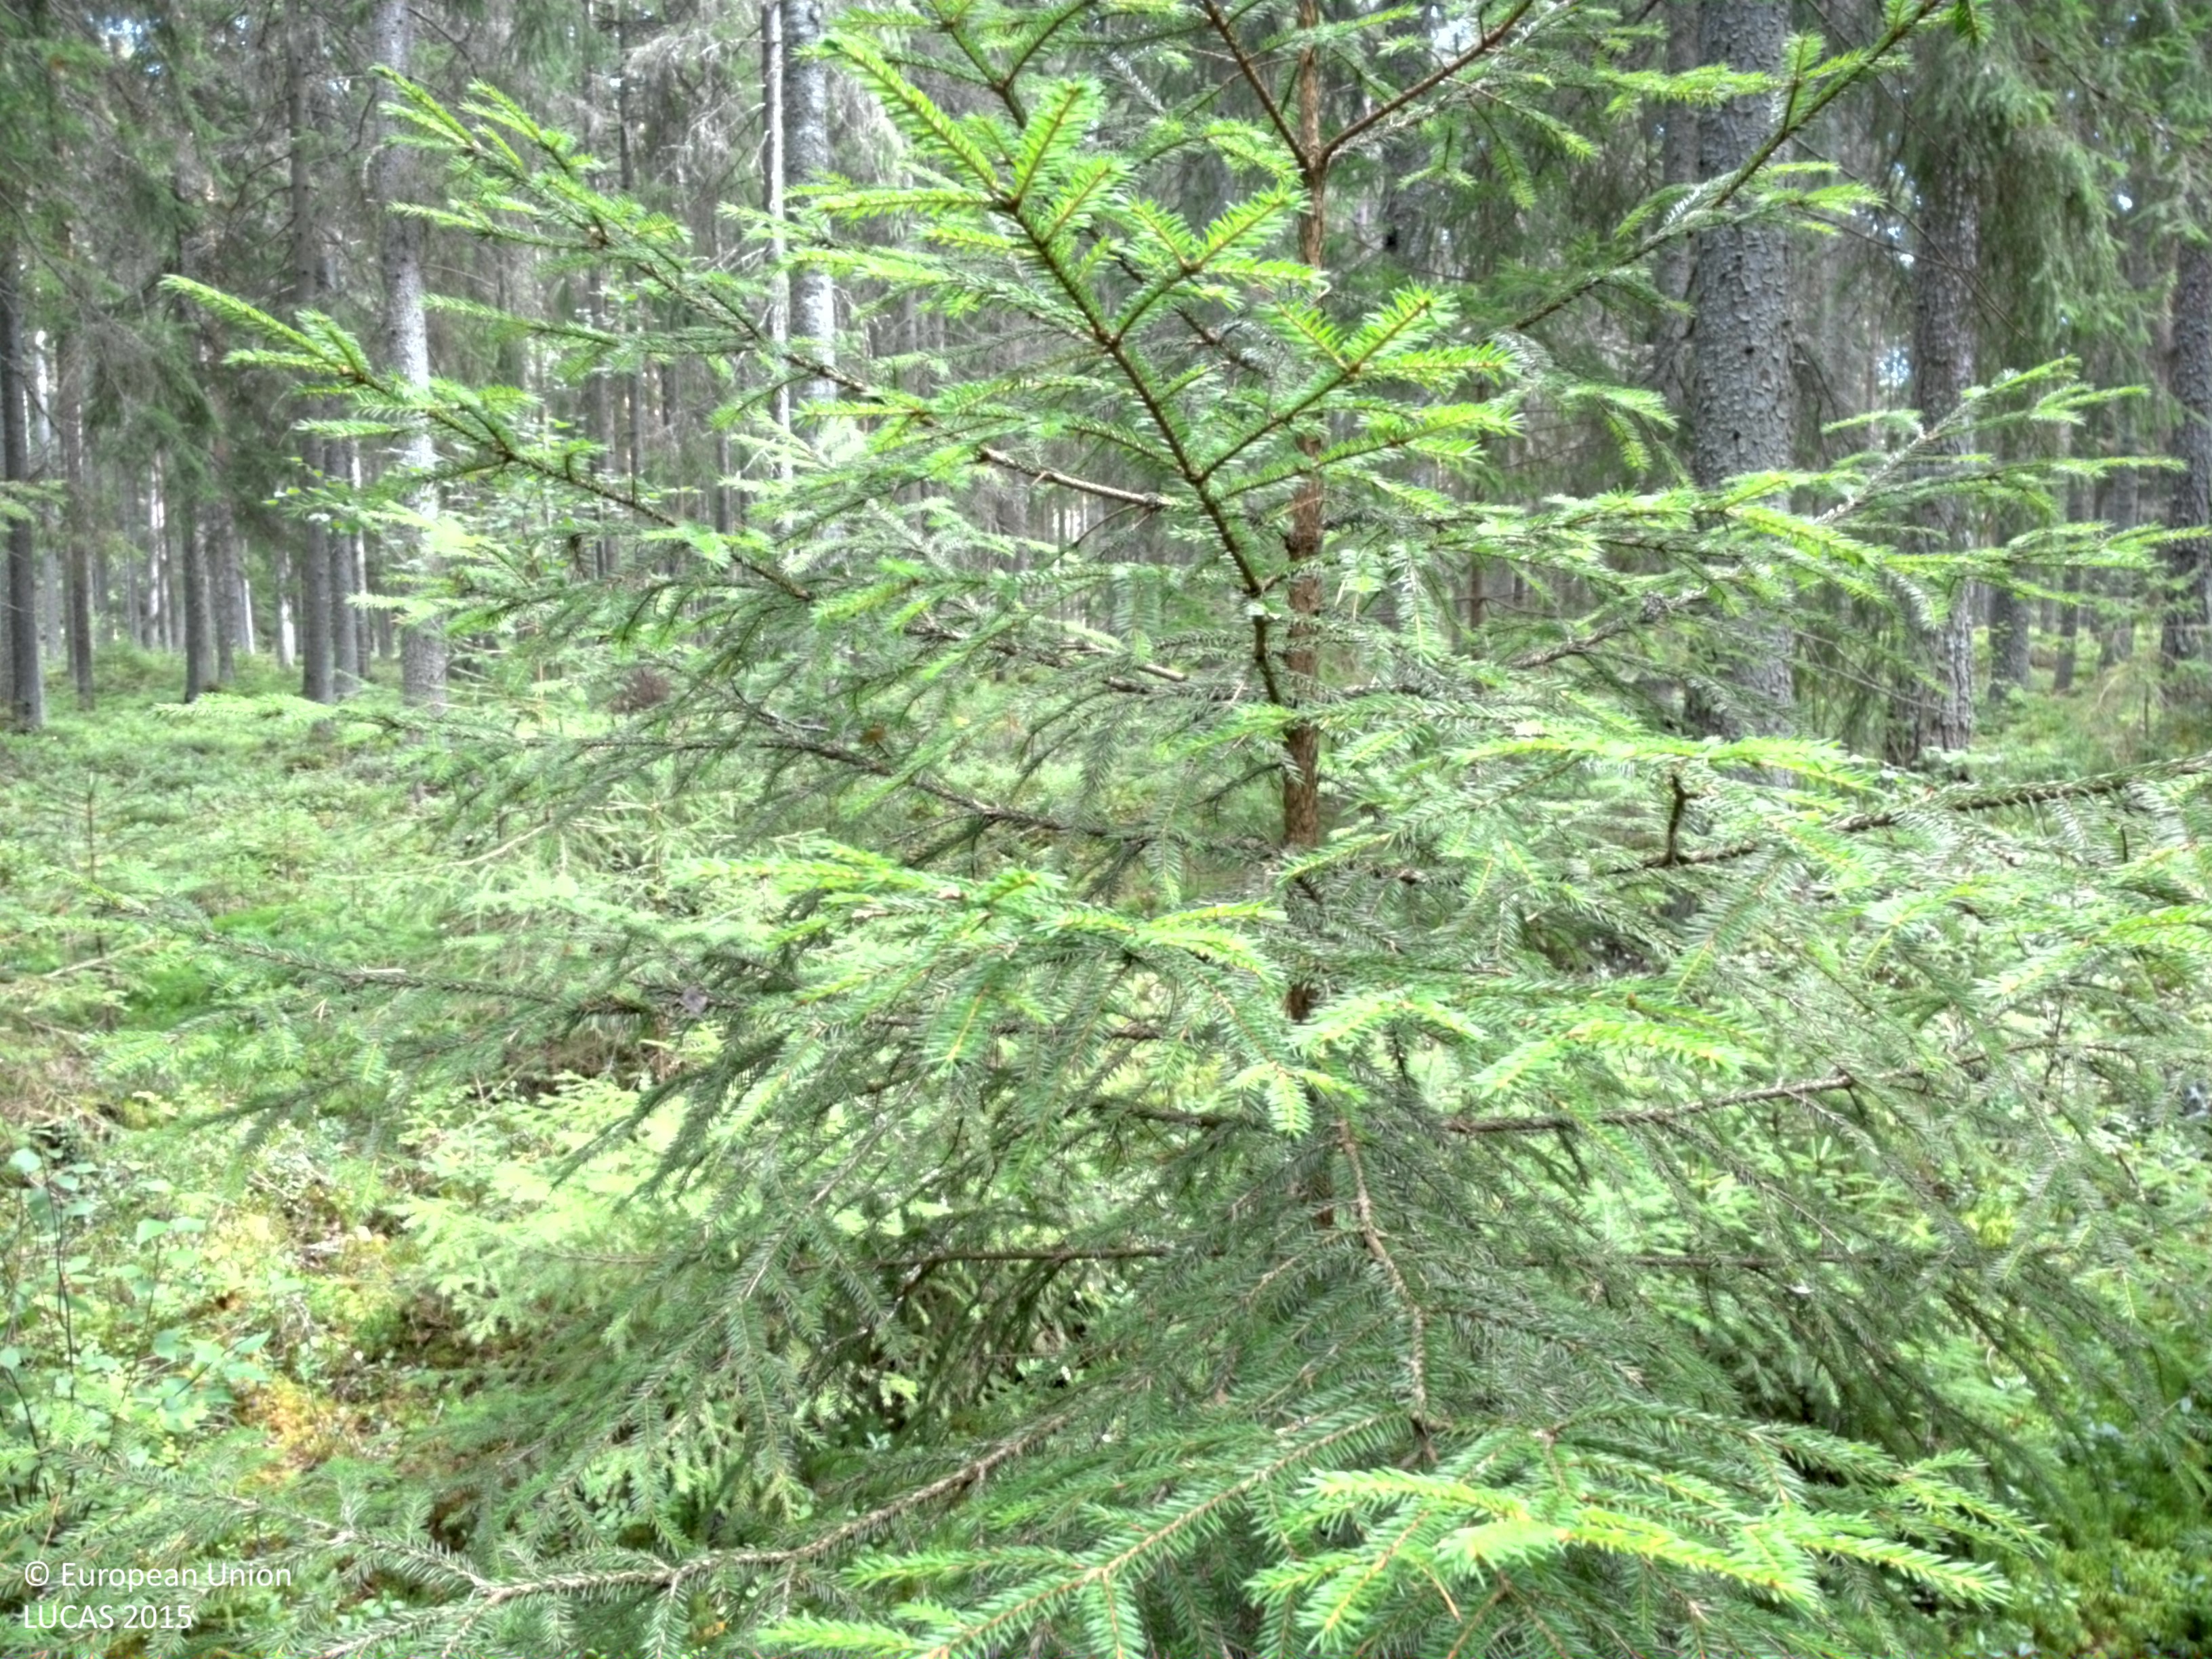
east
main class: Woodland
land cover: Other coniferous woodland
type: boreal forest
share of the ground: > 75 %
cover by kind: coniferous forest trees 75 %, shrubs 10 %, lichens and mosses 10 %, broadleaved forest trees 5 %
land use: Forestry
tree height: > 5 m
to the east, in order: Other coniferous woodland; Tracks; Other coniferous woodland; Spruce dominated mixed woodland; Tracks; Spruce dominated mixed woodland; Tracks; Pine dominated coniferous woodland; Other coniferous woodland
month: August
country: SE
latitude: 59.9850
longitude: 16.3168
